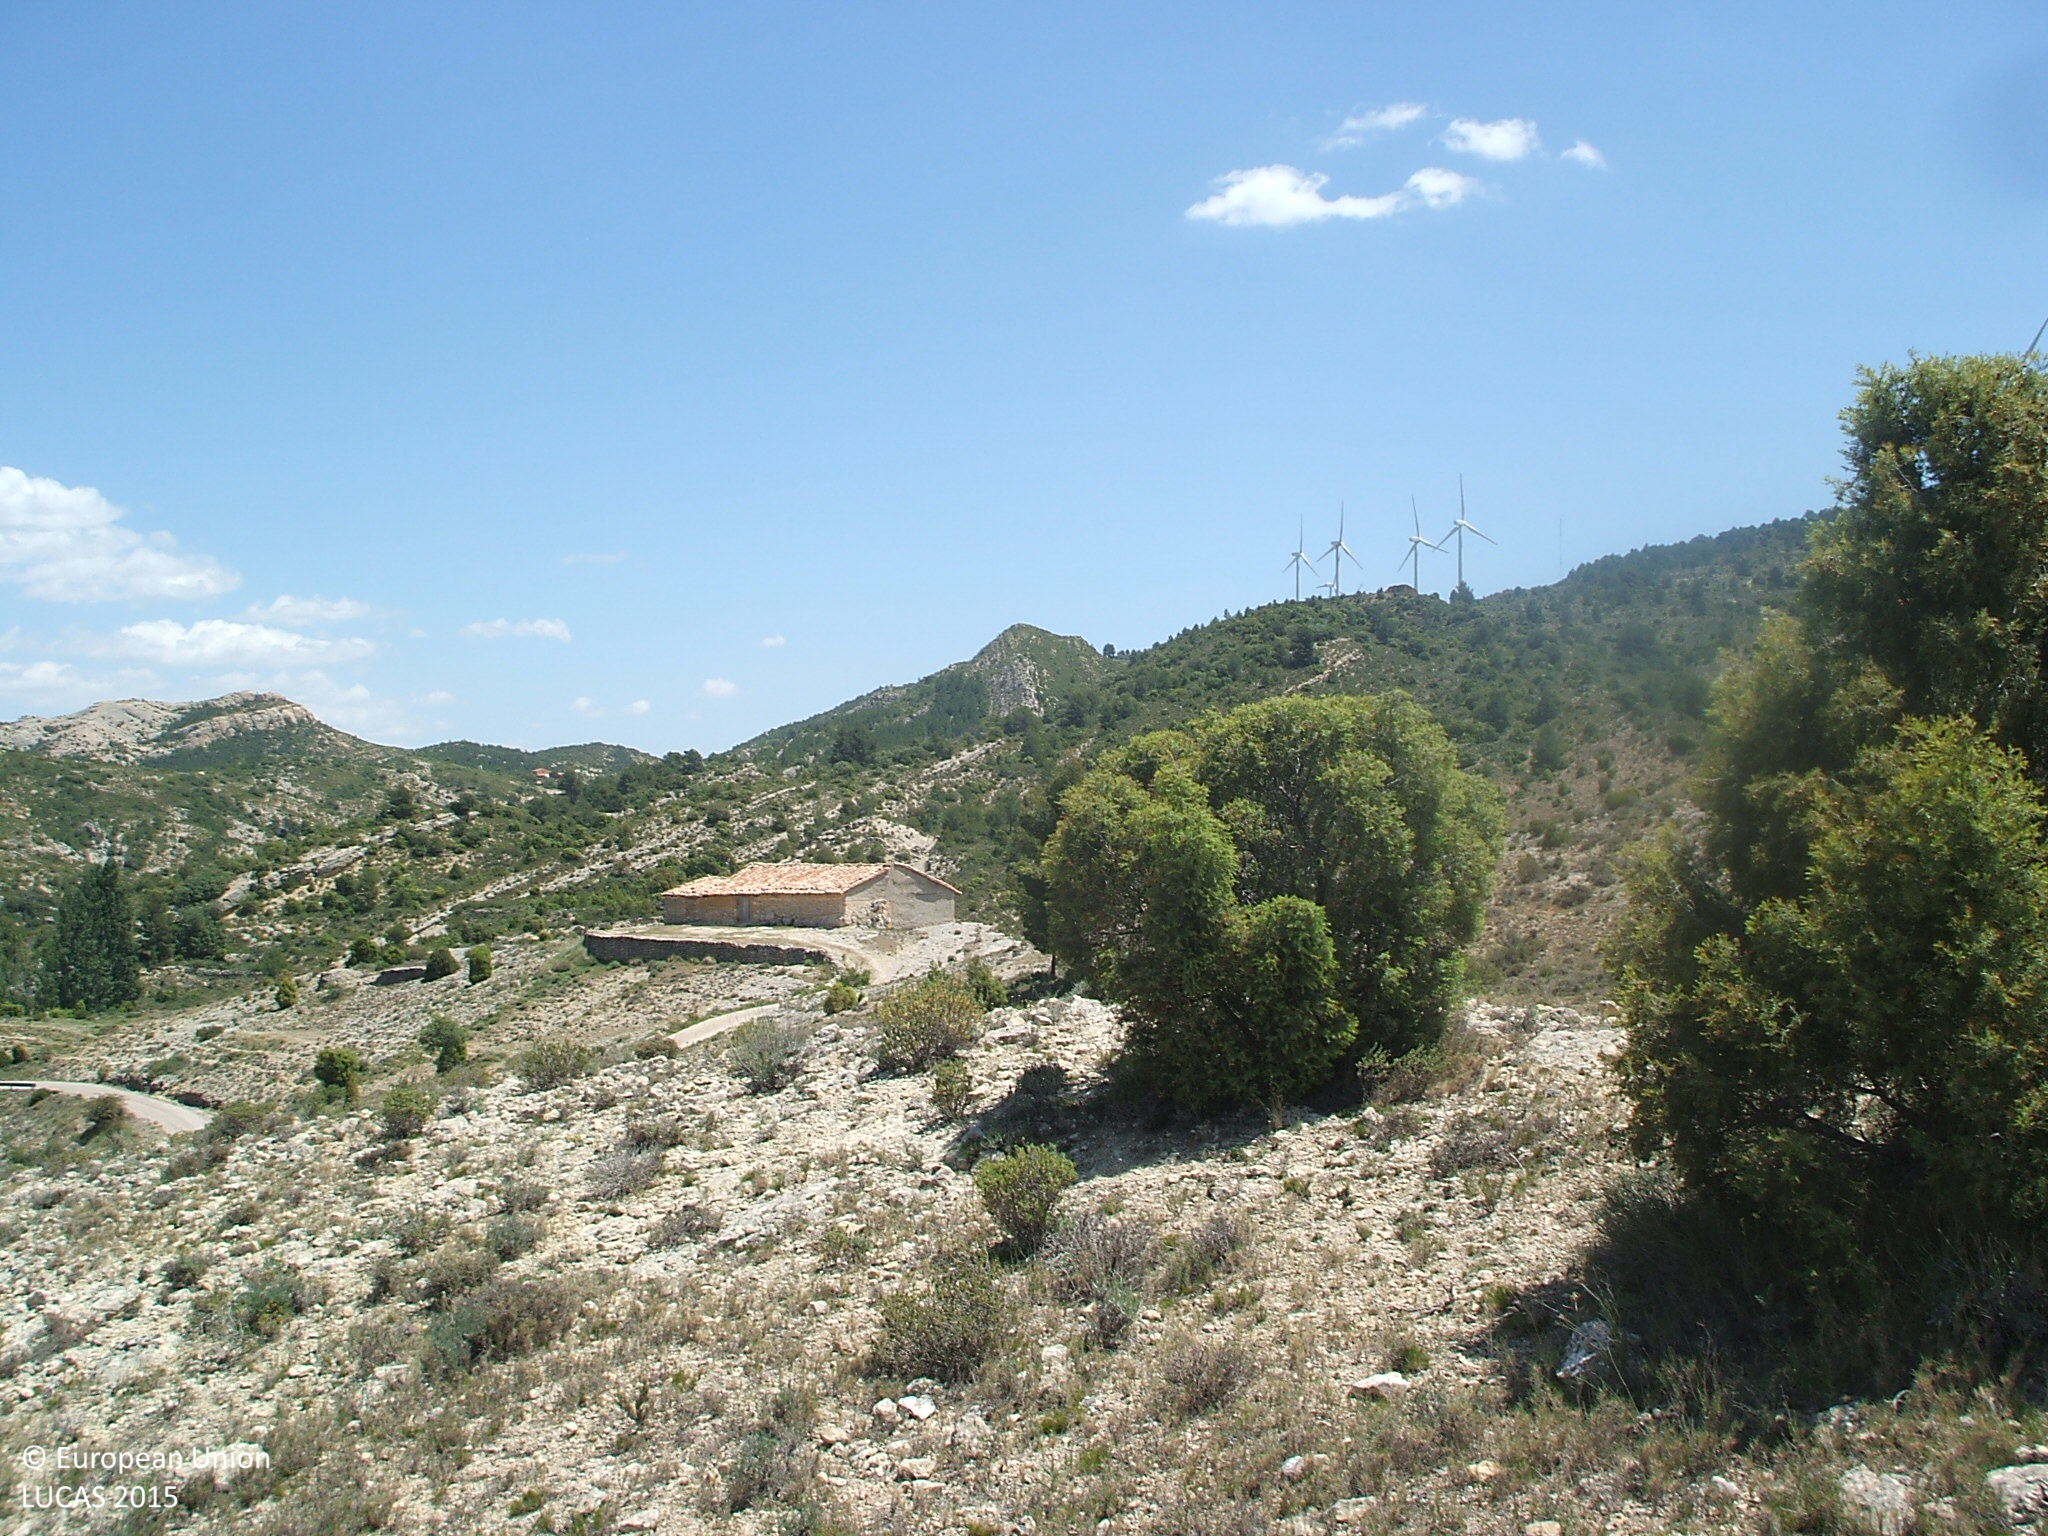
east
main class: Shrubland
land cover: Shrubland with sparse tree cover
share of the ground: 25 - 50 %
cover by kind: consolidated bare surface 55 %, shrubs 20 %, herbaceous plants 20 %, broadleaved forest trees 5 %
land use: Agriculture (excluding fallow land and kitchen gardens)
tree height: > 5 m
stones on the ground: > 50 %
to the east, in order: Shrubland with sparse tree cover; Rock outcrops; Shrubland with sparse tree cover; Rock outcrops; Grass margins; Tracks; Grass margins; Dry stone walls; Grassland without tree/shrub cover; Dry stone walls; Grassland without tree/shrub cover; Other fresh vegetables; Dry stone walls; Grassland with sparse tree/shrub cover; Shruby margins; Ditches and canals; Shruby margins
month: May
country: ES
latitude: 40.6928
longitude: -0.2687
